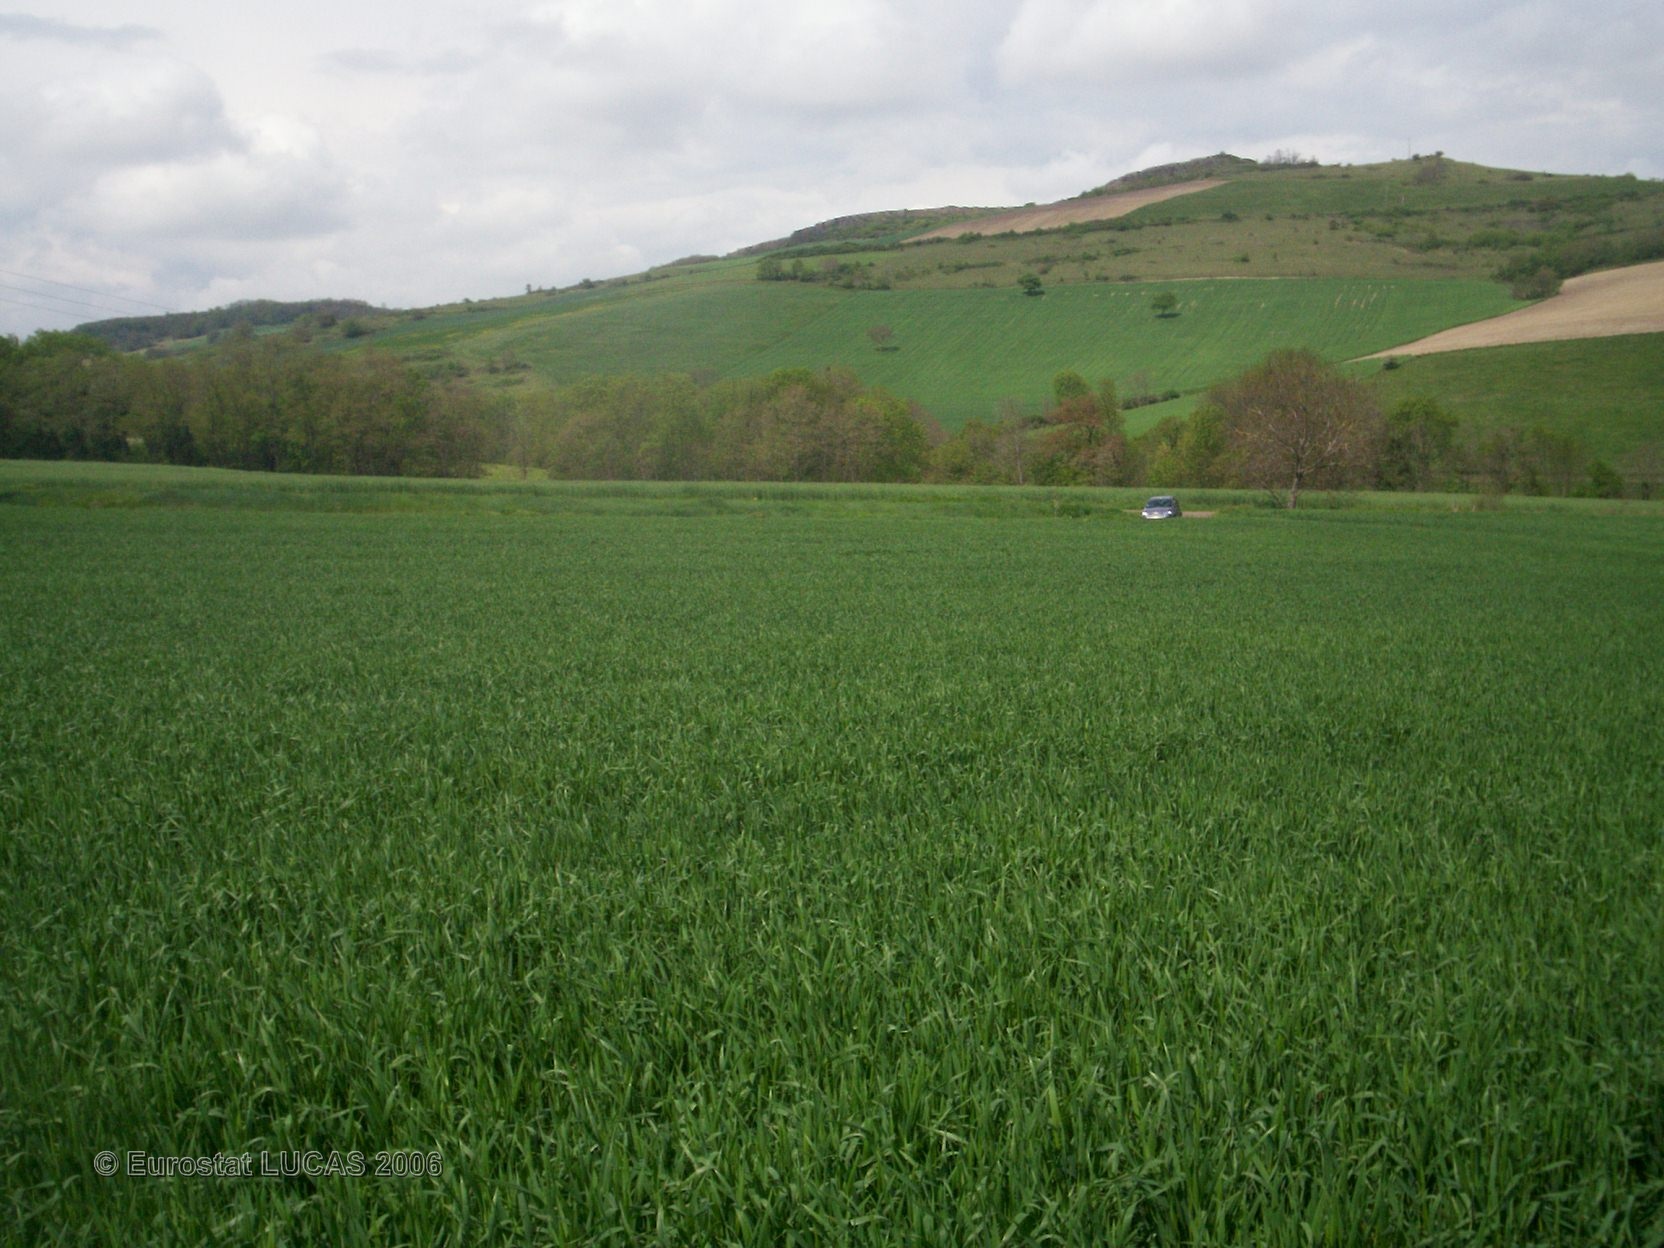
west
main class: Cropland
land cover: Common wheat
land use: Agriculture (excluding fallow land and kitchen gardens)
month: May
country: FR
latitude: 45.5757
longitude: 3.2217
